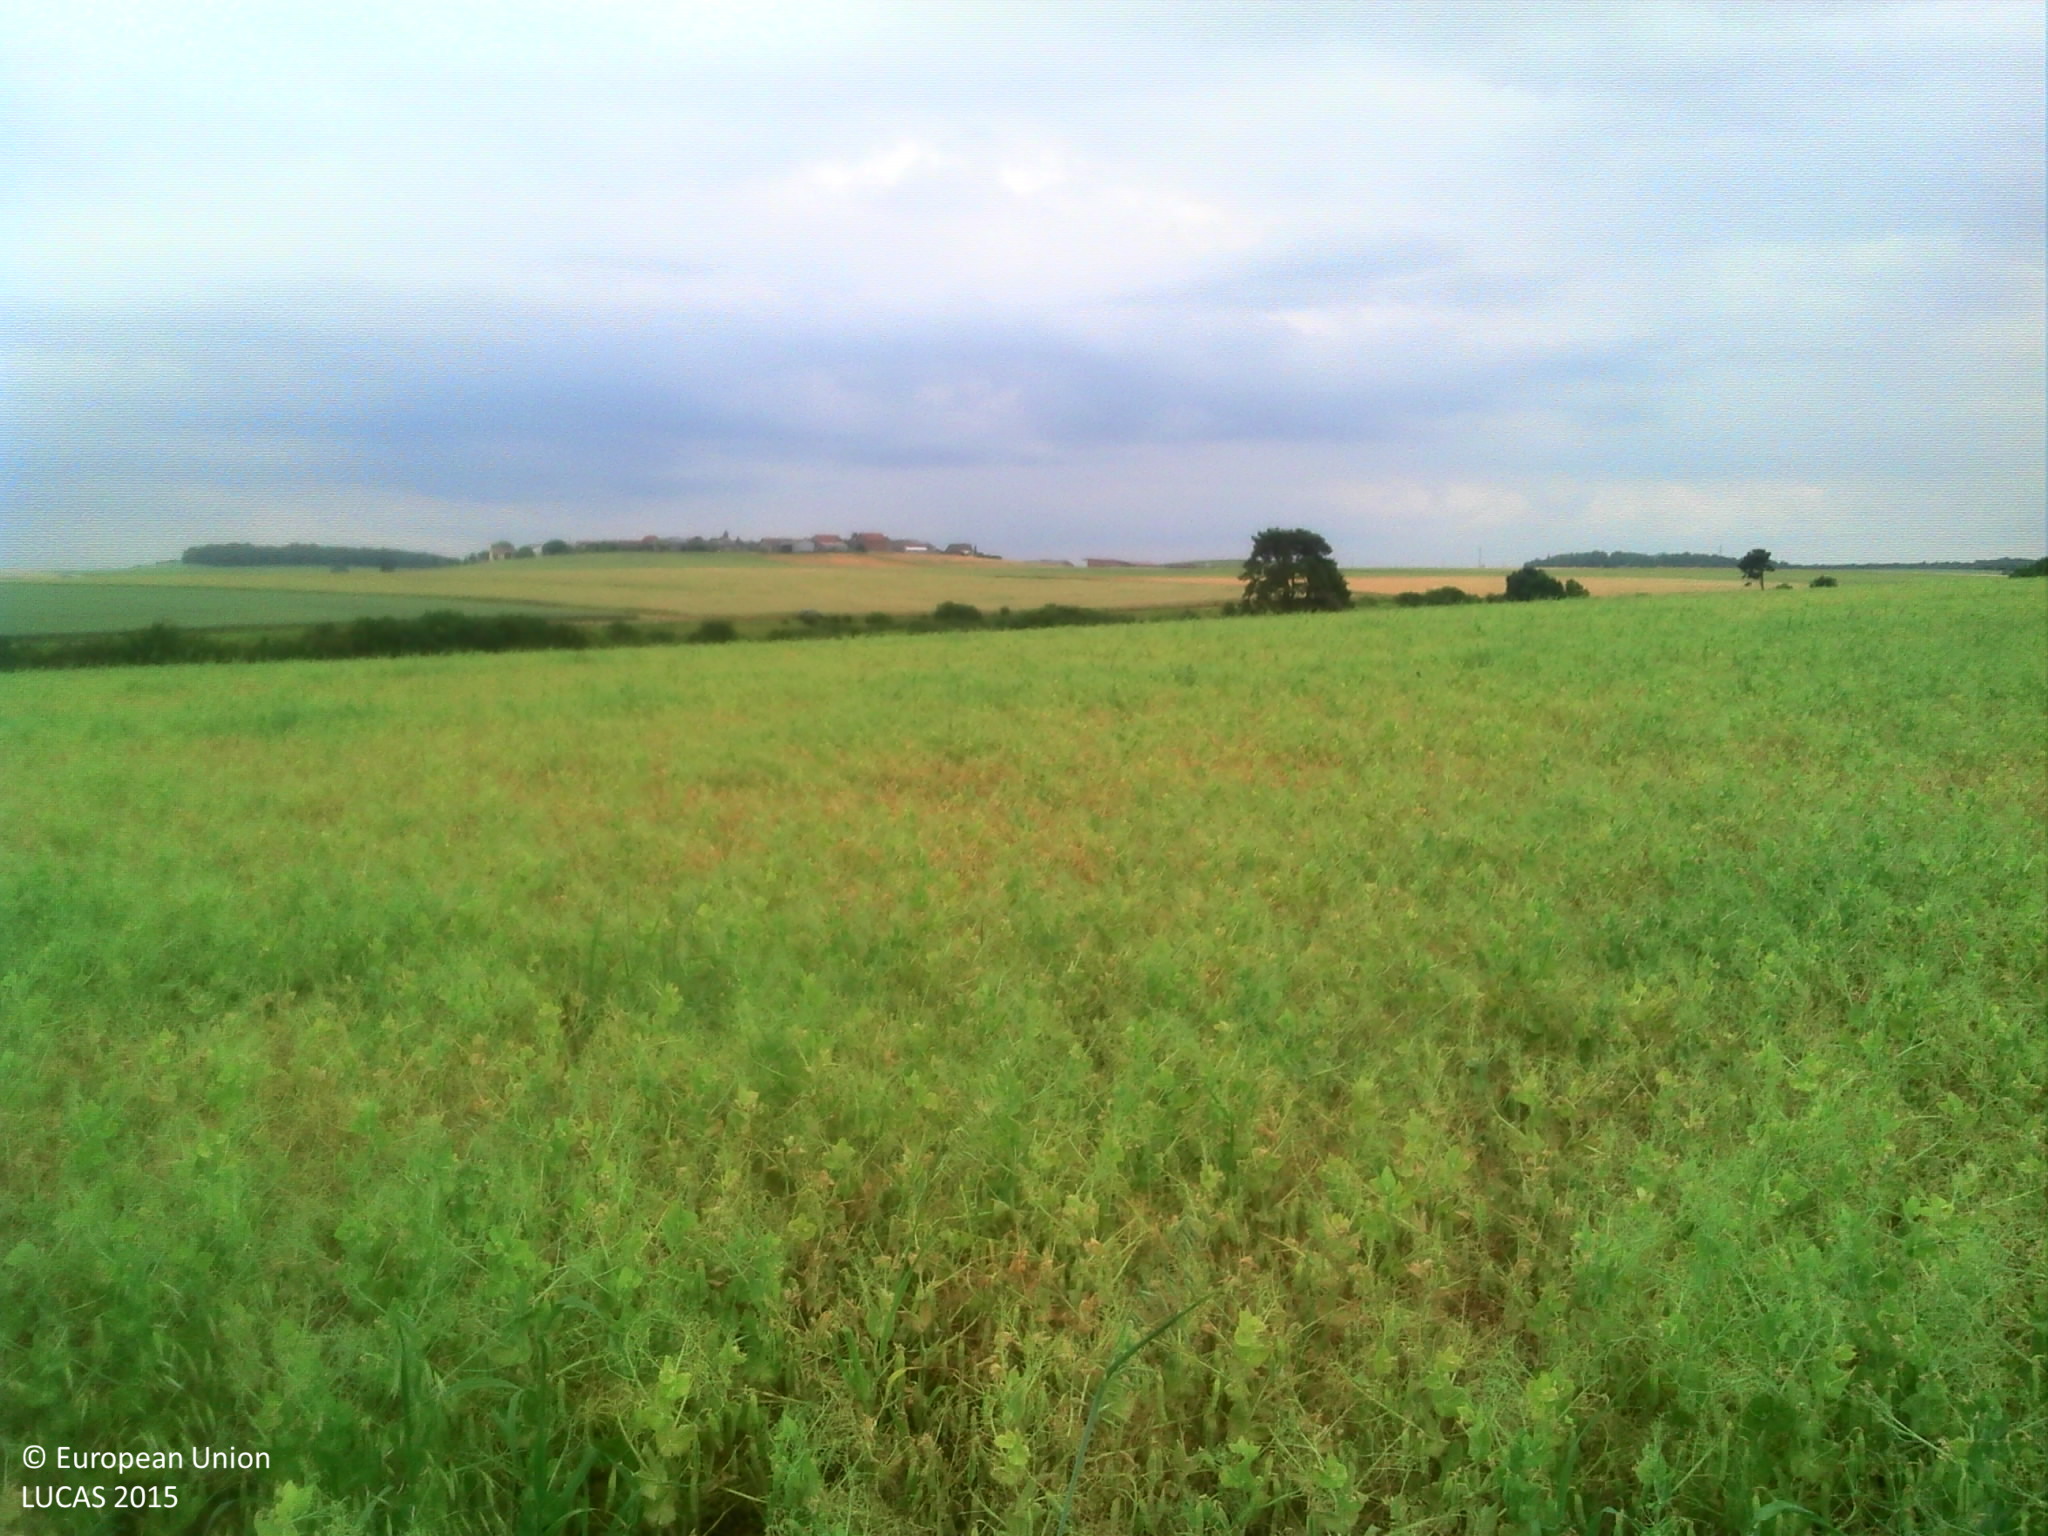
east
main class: Cropland
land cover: Dry pulses
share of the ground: > 75 %
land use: Agriculture (excluding fallow land and kitchen gardens)
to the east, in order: Dry pulses; Abandoned hedges; Dry pulses; Fences; Shrubland with sparse tree cover; Grass margins; Tracks; Grass margins; Common wheat
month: June
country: FR
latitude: 48.2916
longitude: 5.0252
